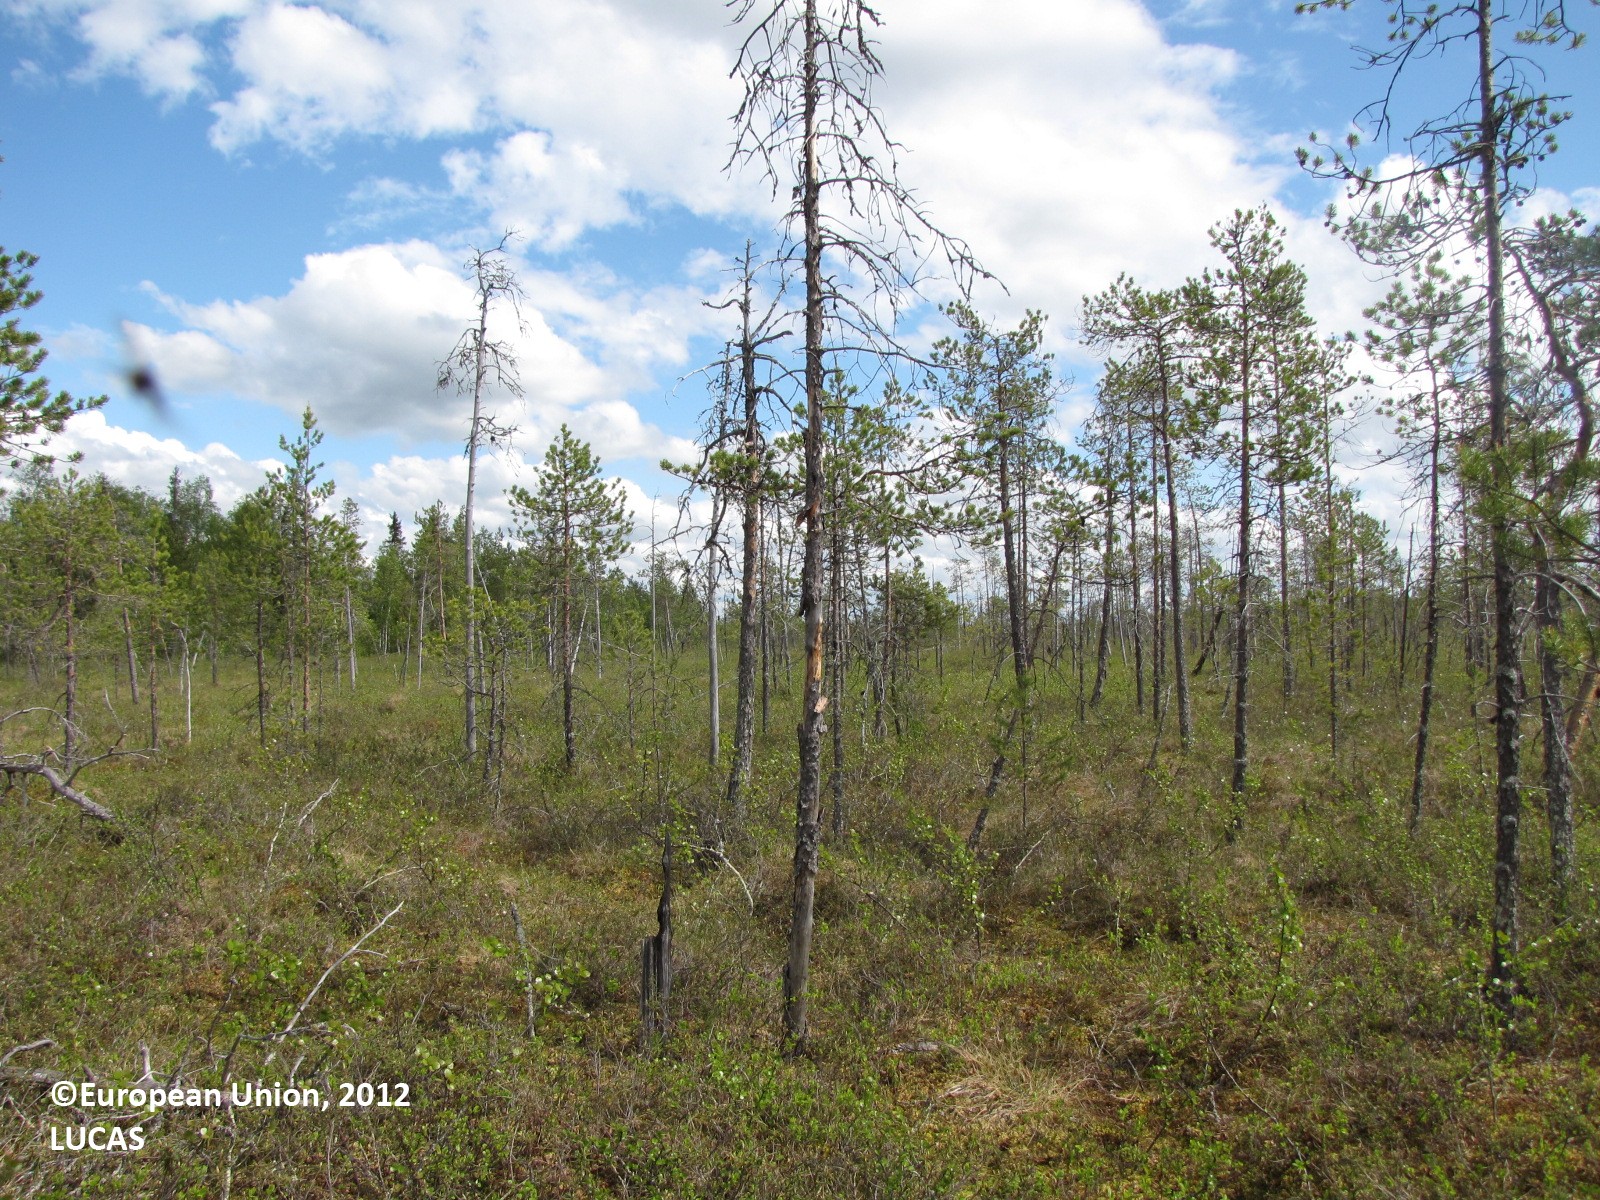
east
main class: Woodland
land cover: Pine dominated coniferous woodland
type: boreal forest
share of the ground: 10 - 25 %
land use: Forestry
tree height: > 5 m
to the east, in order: Pine dominated coniferous woodland; Other mixed woodland; Peatbogs; Electric lines; Peatbogs; Pine dominated coniferous woodland
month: June
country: FI
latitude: 66.0991
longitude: 25.2151
